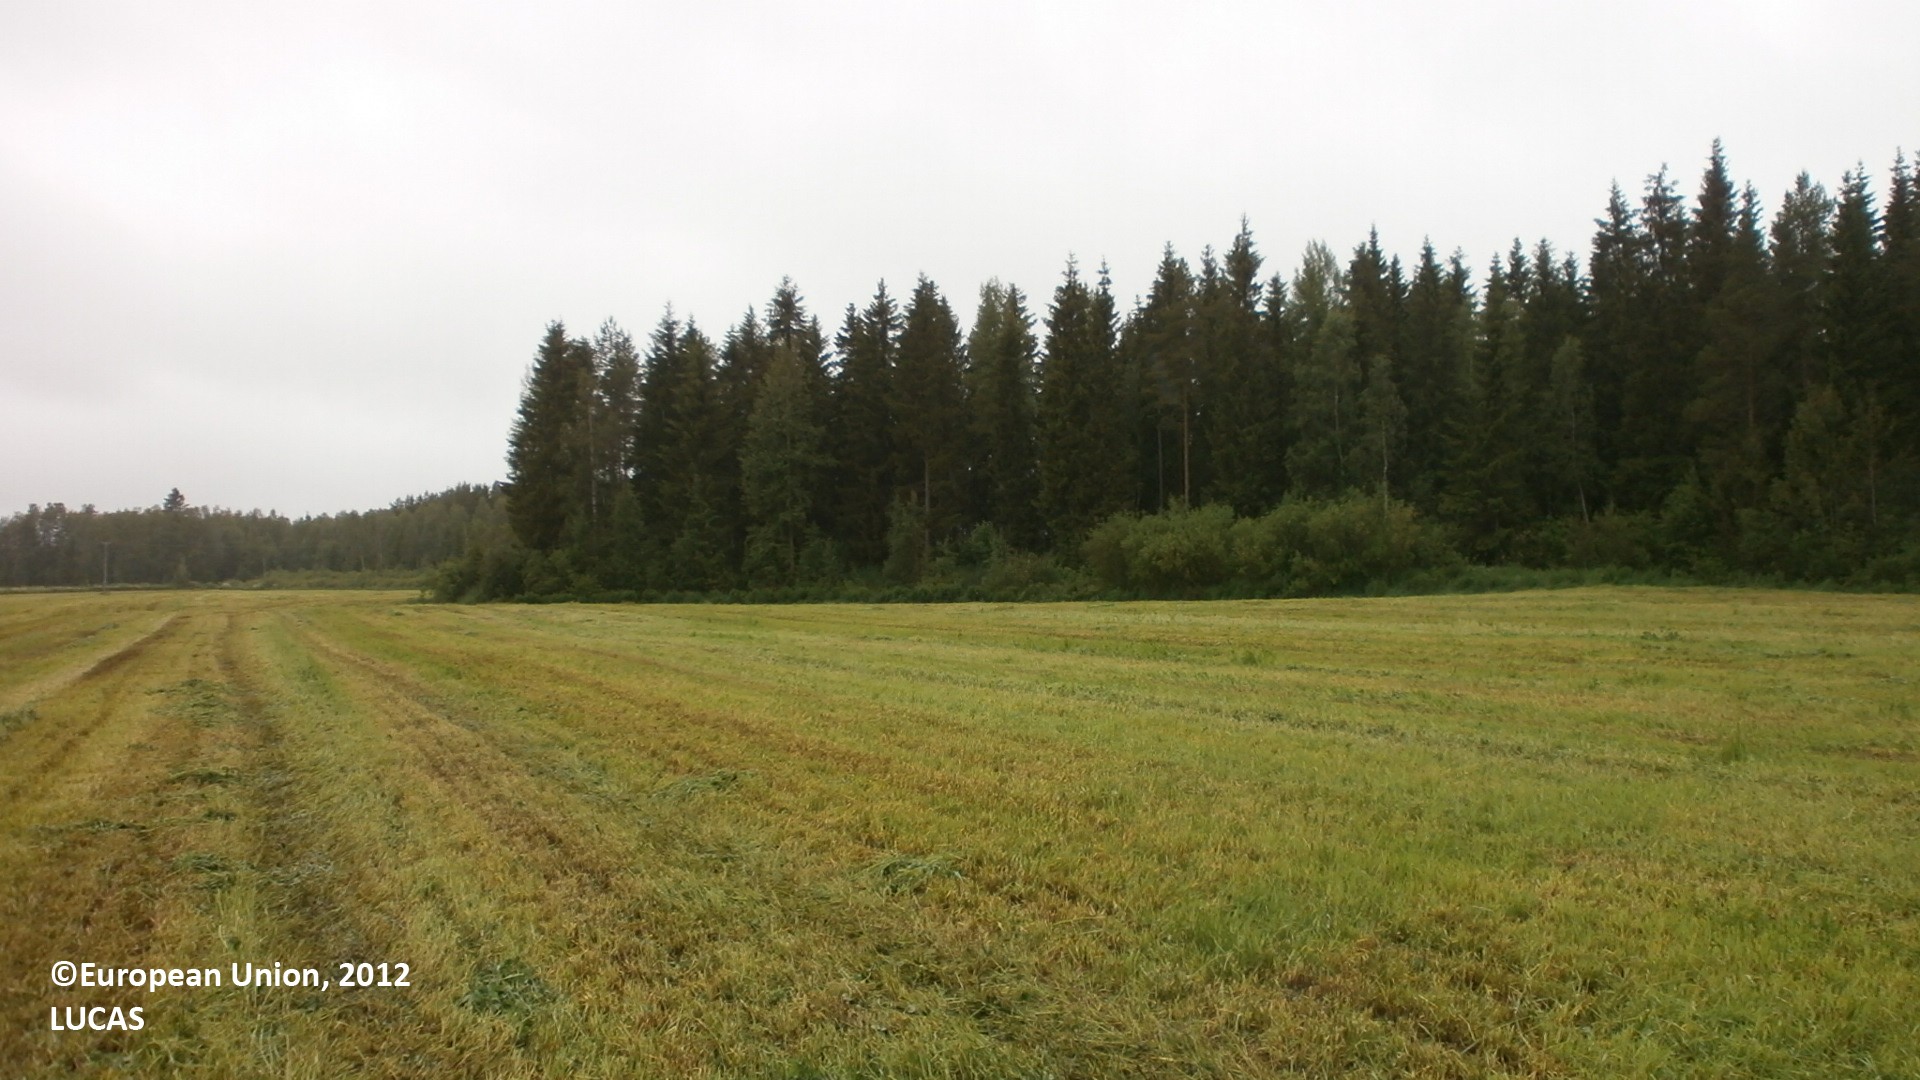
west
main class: Grassland
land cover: Grassland without tree/shrub cover
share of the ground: > 75 %
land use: Agriculture (excluding fallow land and kitchen gardens)
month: June
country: FI
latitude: 64.6281
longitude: 25.1190
